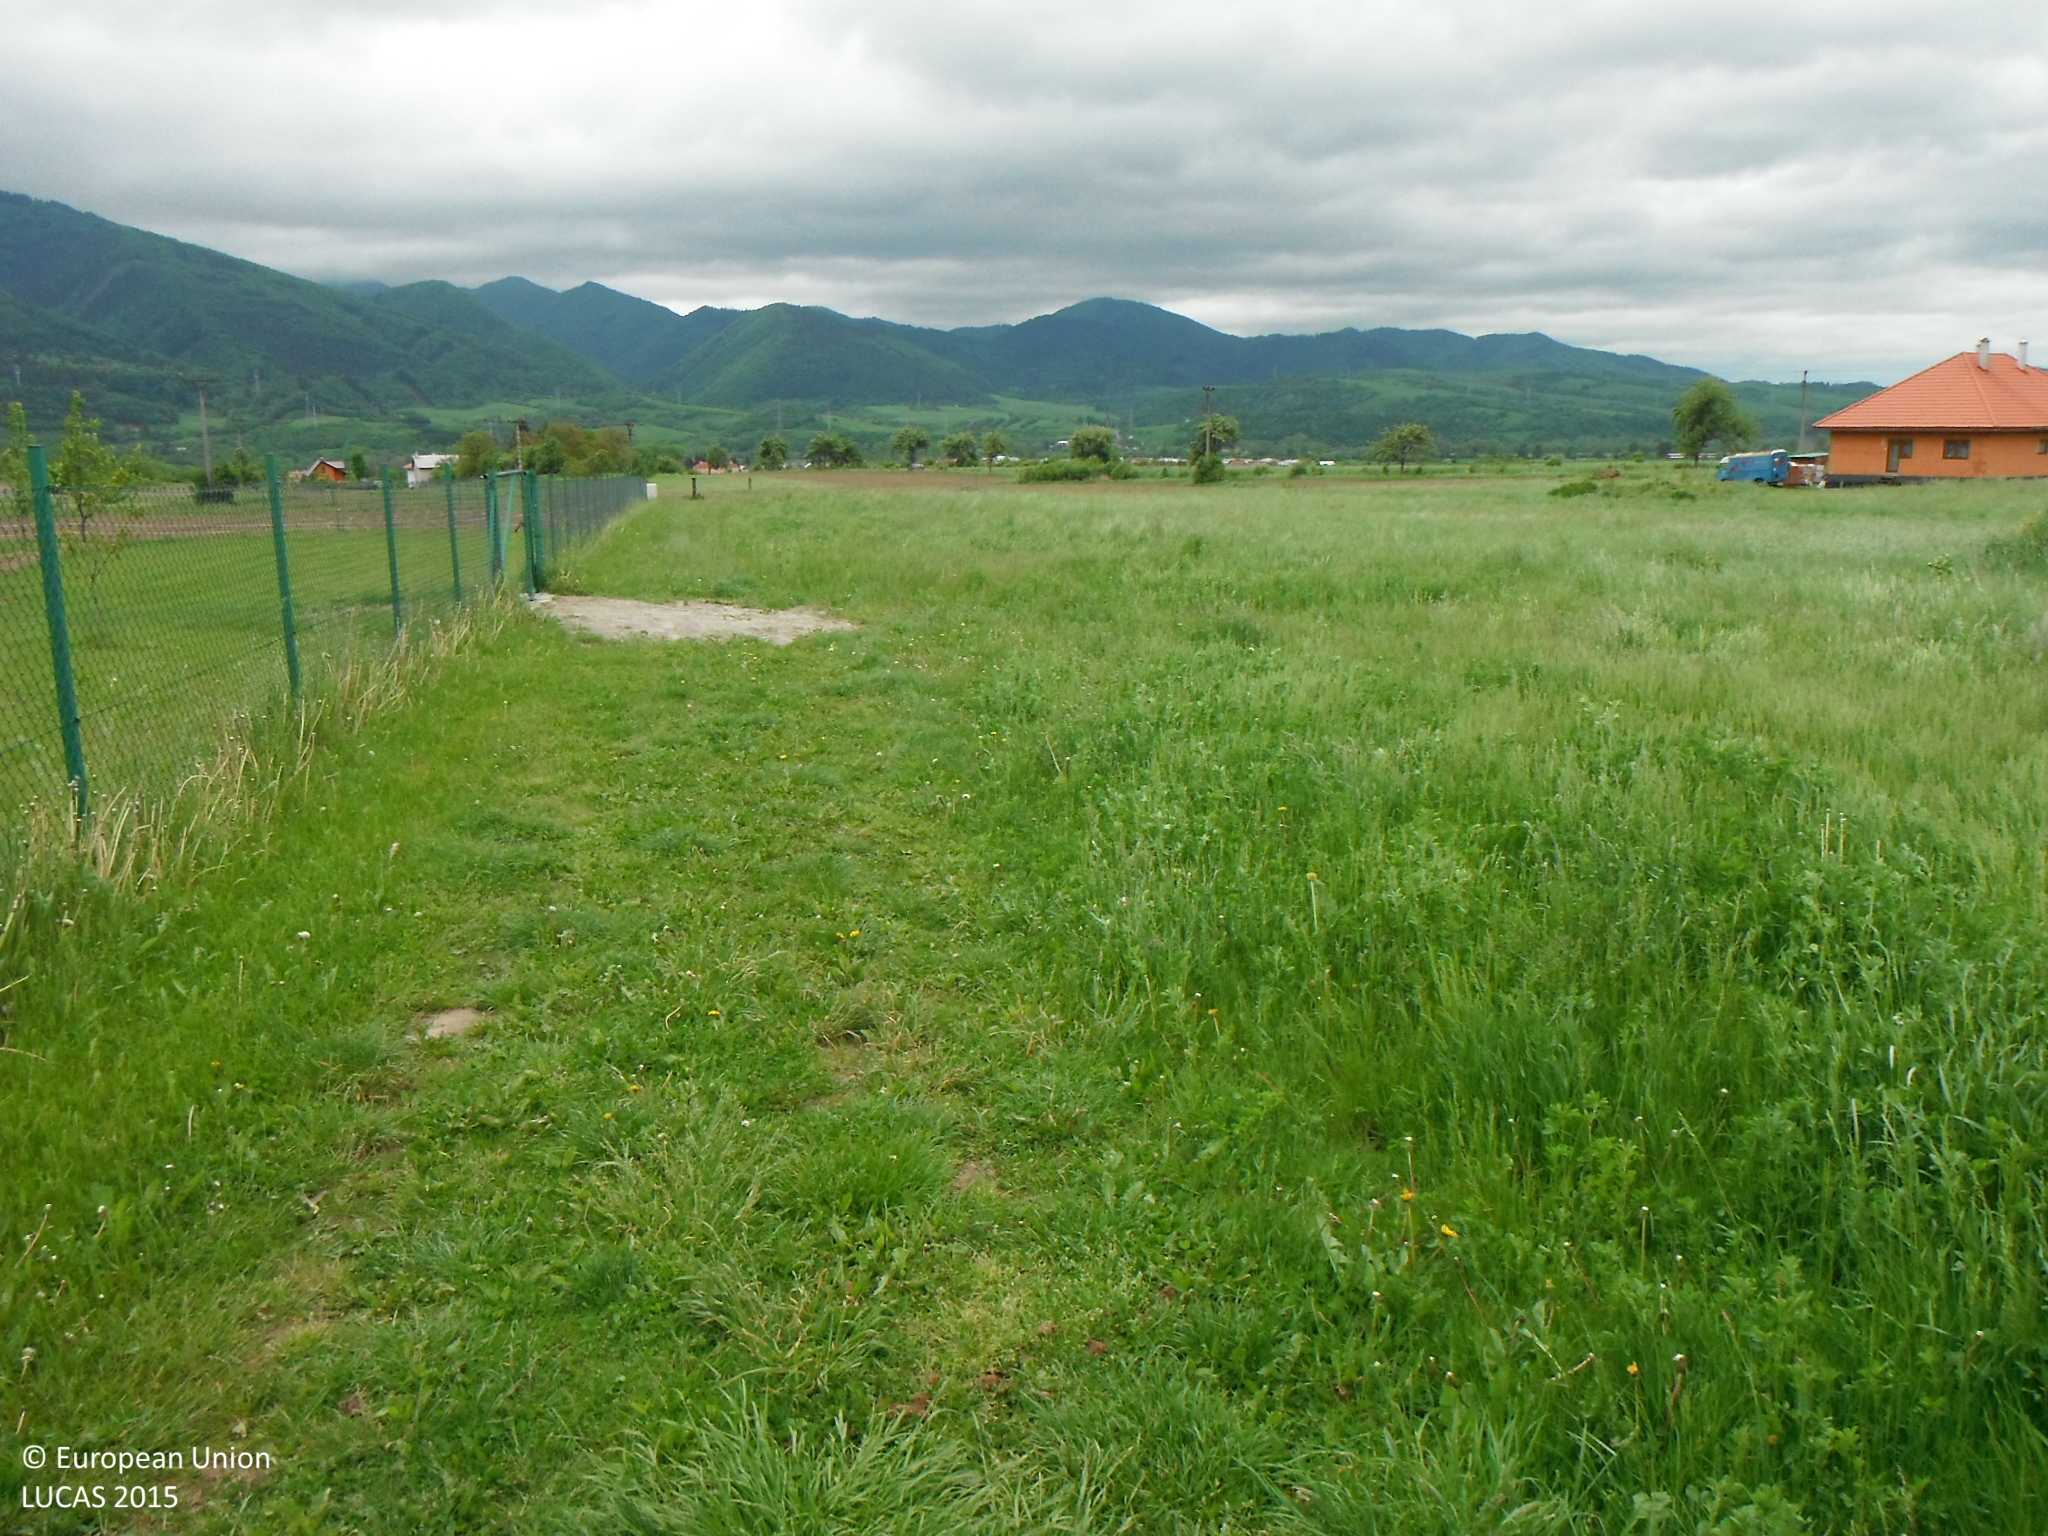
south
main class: Grassland
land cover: Grassland without tree/shrub cover
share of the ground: > 75 %
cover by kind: herbaceous plants 100 %
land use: Residential
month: May
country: SK
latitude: 49.1334
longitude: 19.0819
